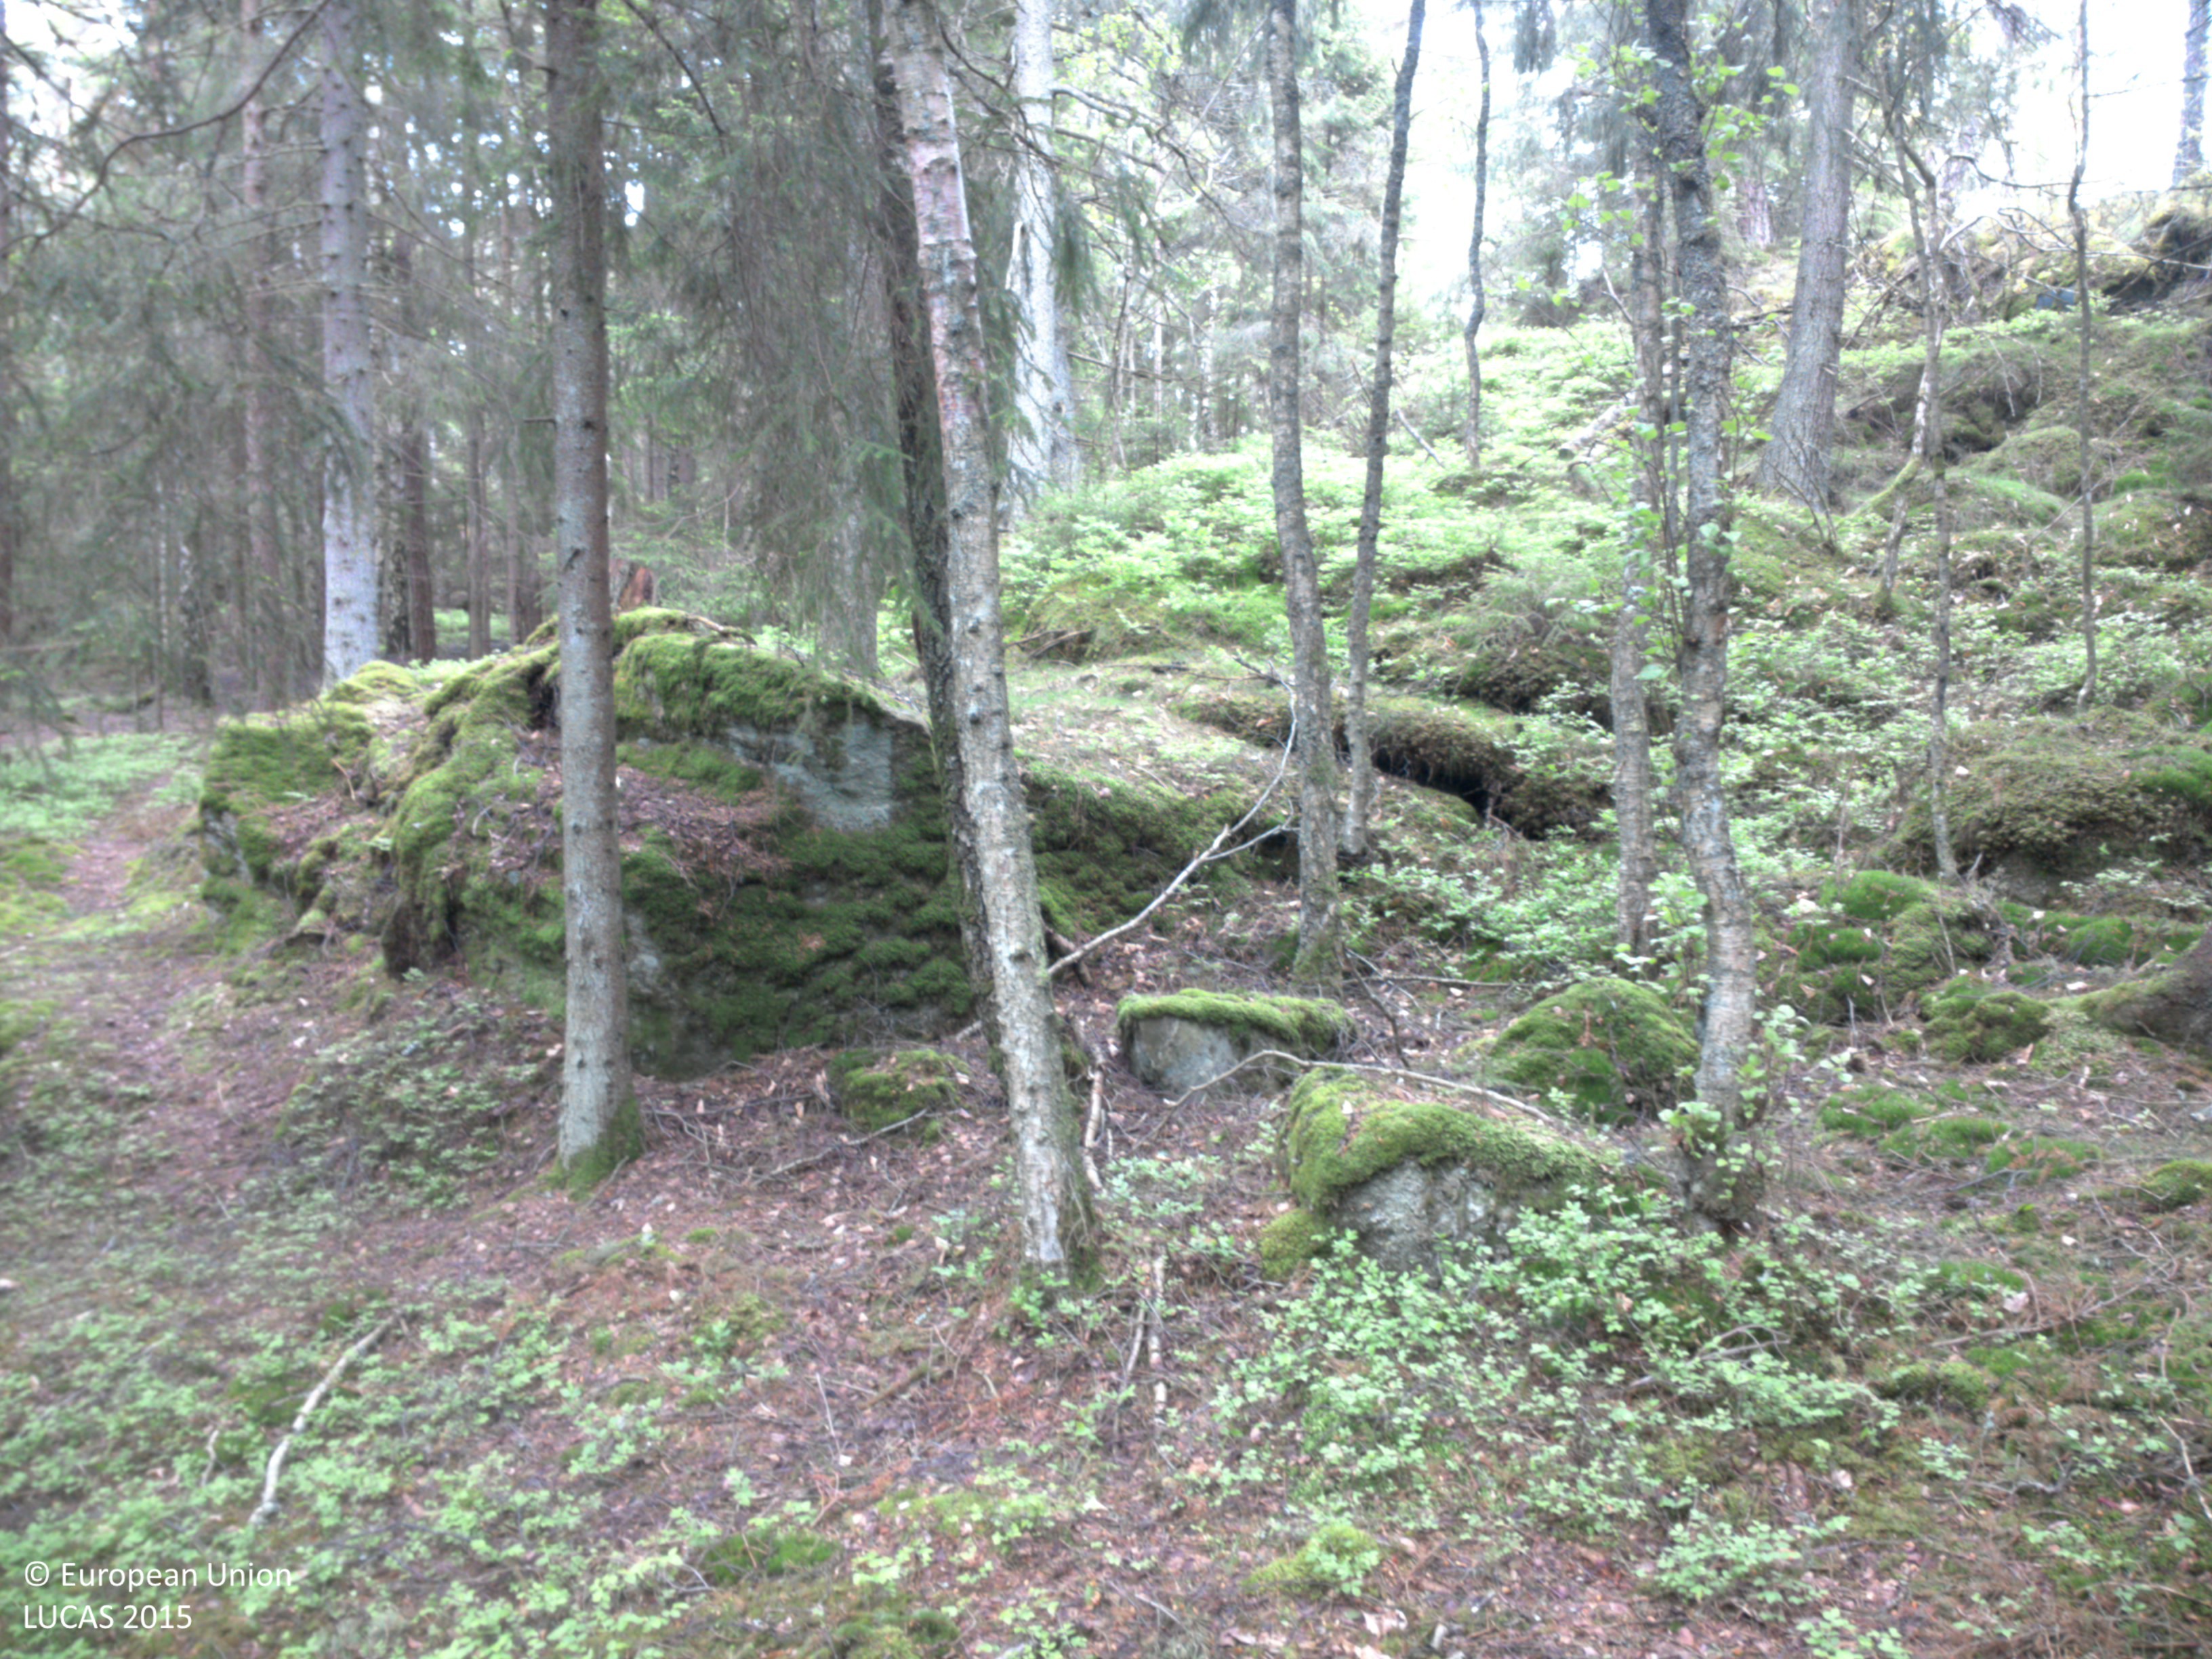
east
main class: Woodland
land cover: Spruce dominated coniferous woodland
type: boreal forest
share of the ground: 50 - 75 %
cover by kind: coniferous forest trees 65 %, herbaceous plants 30 %, broadleaved forest trees 5 %
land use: Forestry
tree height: > 5 m
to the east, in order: Spruce dominated coniferous woodland; Spruce dominated mixed woodland; Pine dominated mixed woodland; Electric lines; Pine dominated mixed woodland; Paved roads, cycling and walking lanes; Broadleaved woodland; Grassland with sparse tree/shrub cover; Fences; Ditches and canals; Grassland without tree/shrub cover; Ditches and canals; Fences; Grassland without tree/shrub cover
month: May
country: SE
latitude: 58.2629
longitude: 11.6840
